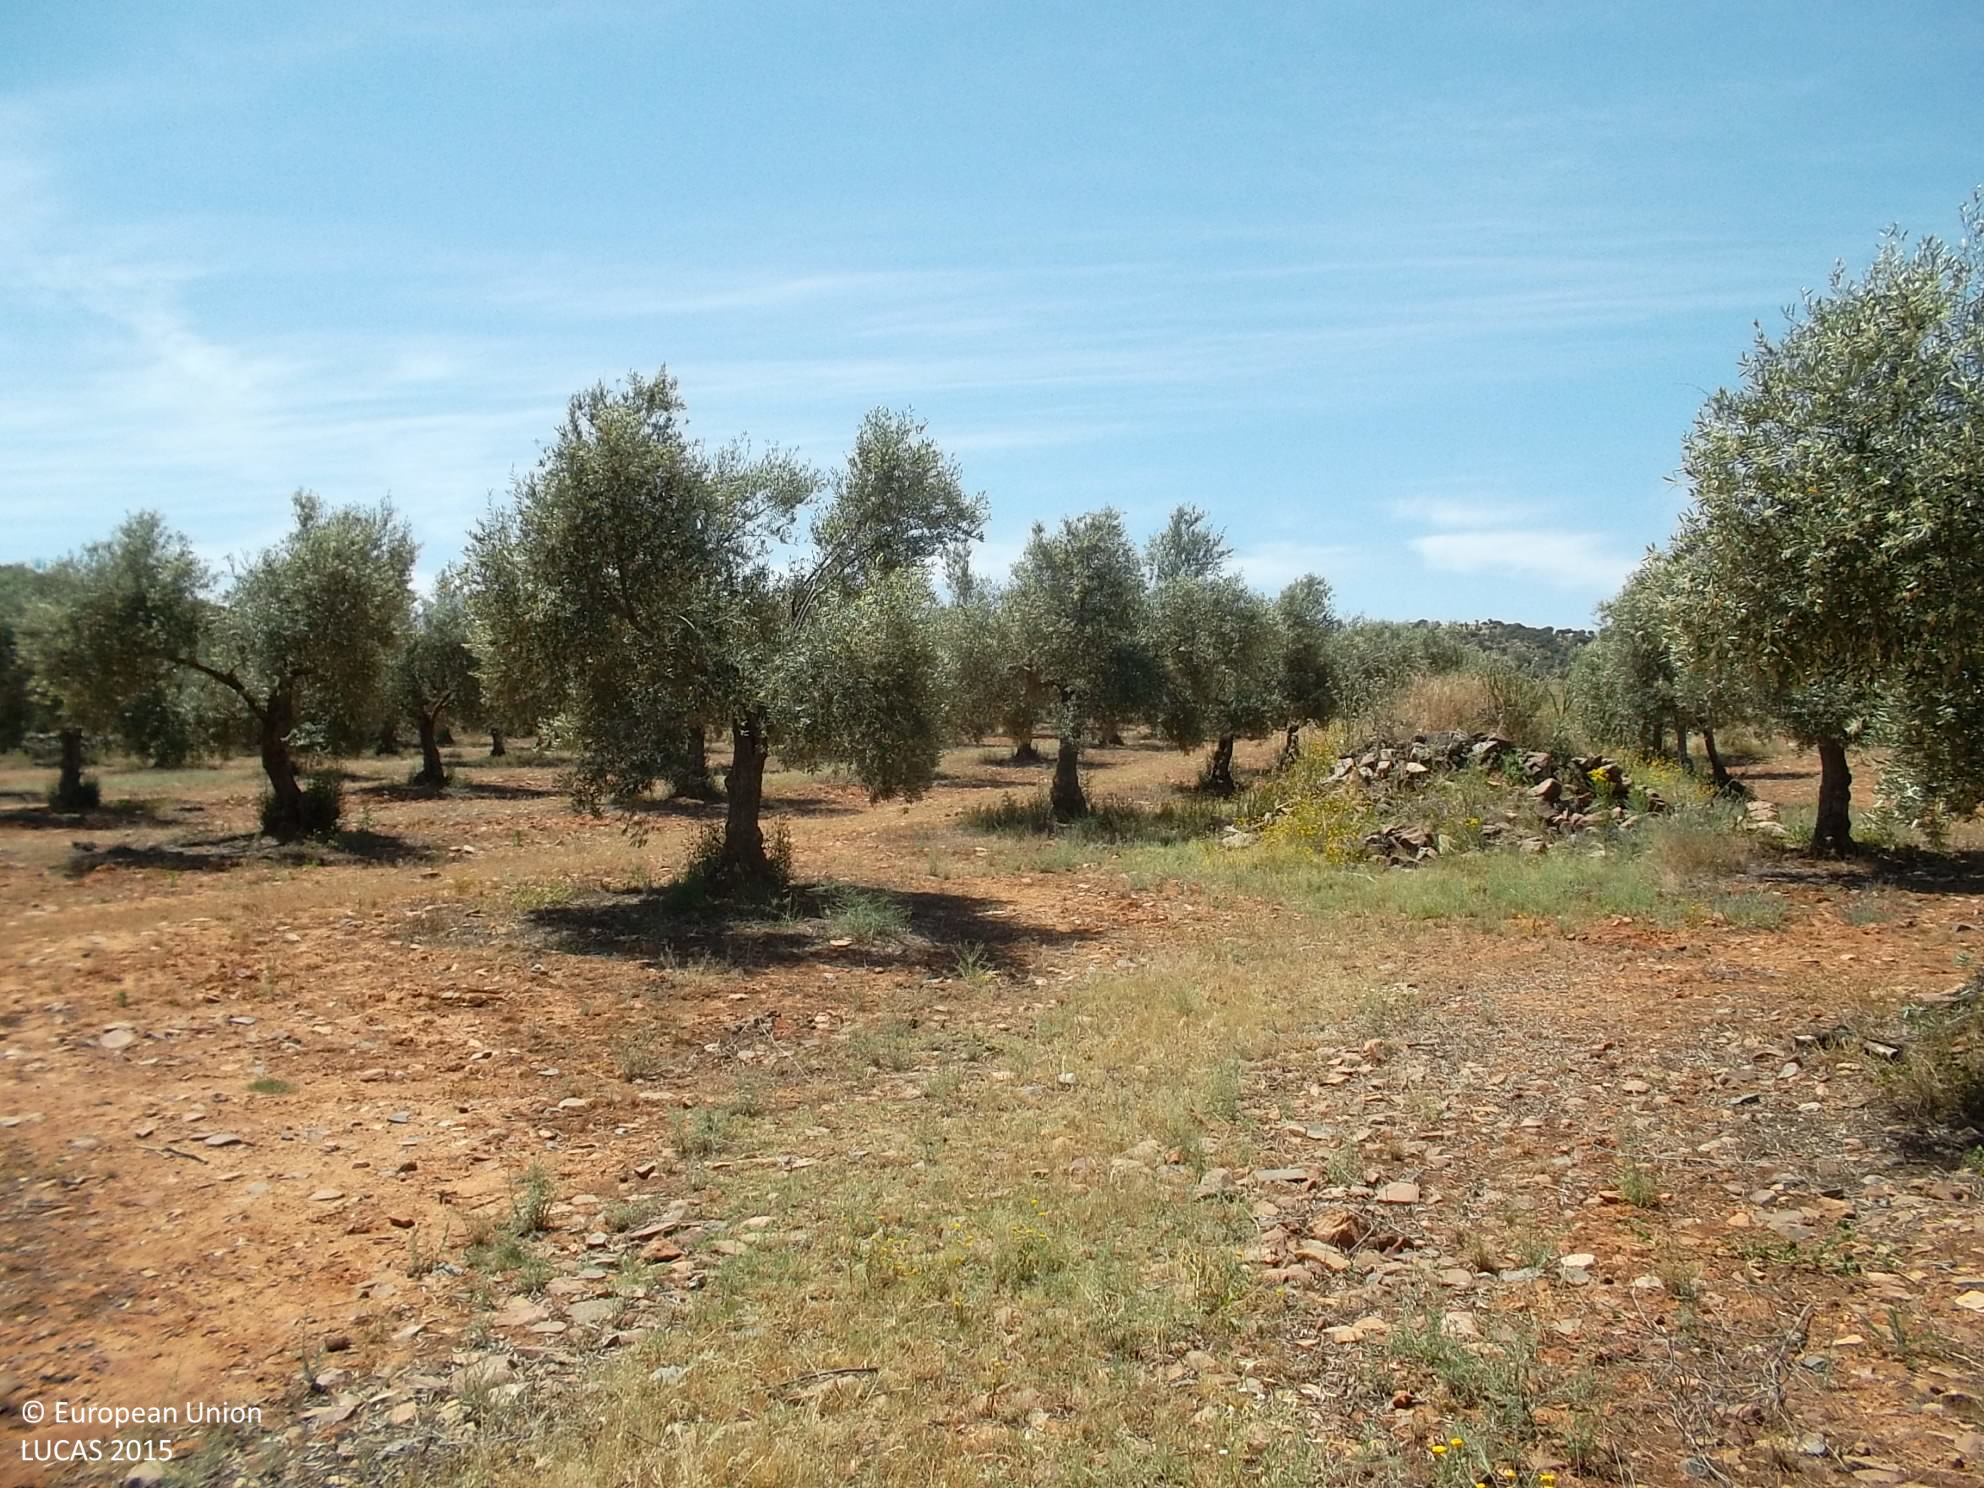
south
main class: Cropland
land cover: Olive groves
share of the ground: 25 - 50 %
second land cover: Spontaneously vegetated surfaces
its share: 25 - 50 %
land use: Agriculture (excluding fallow land and kitchen gardens)
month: May
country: ES
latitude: 38.6612
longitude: -4.7945
